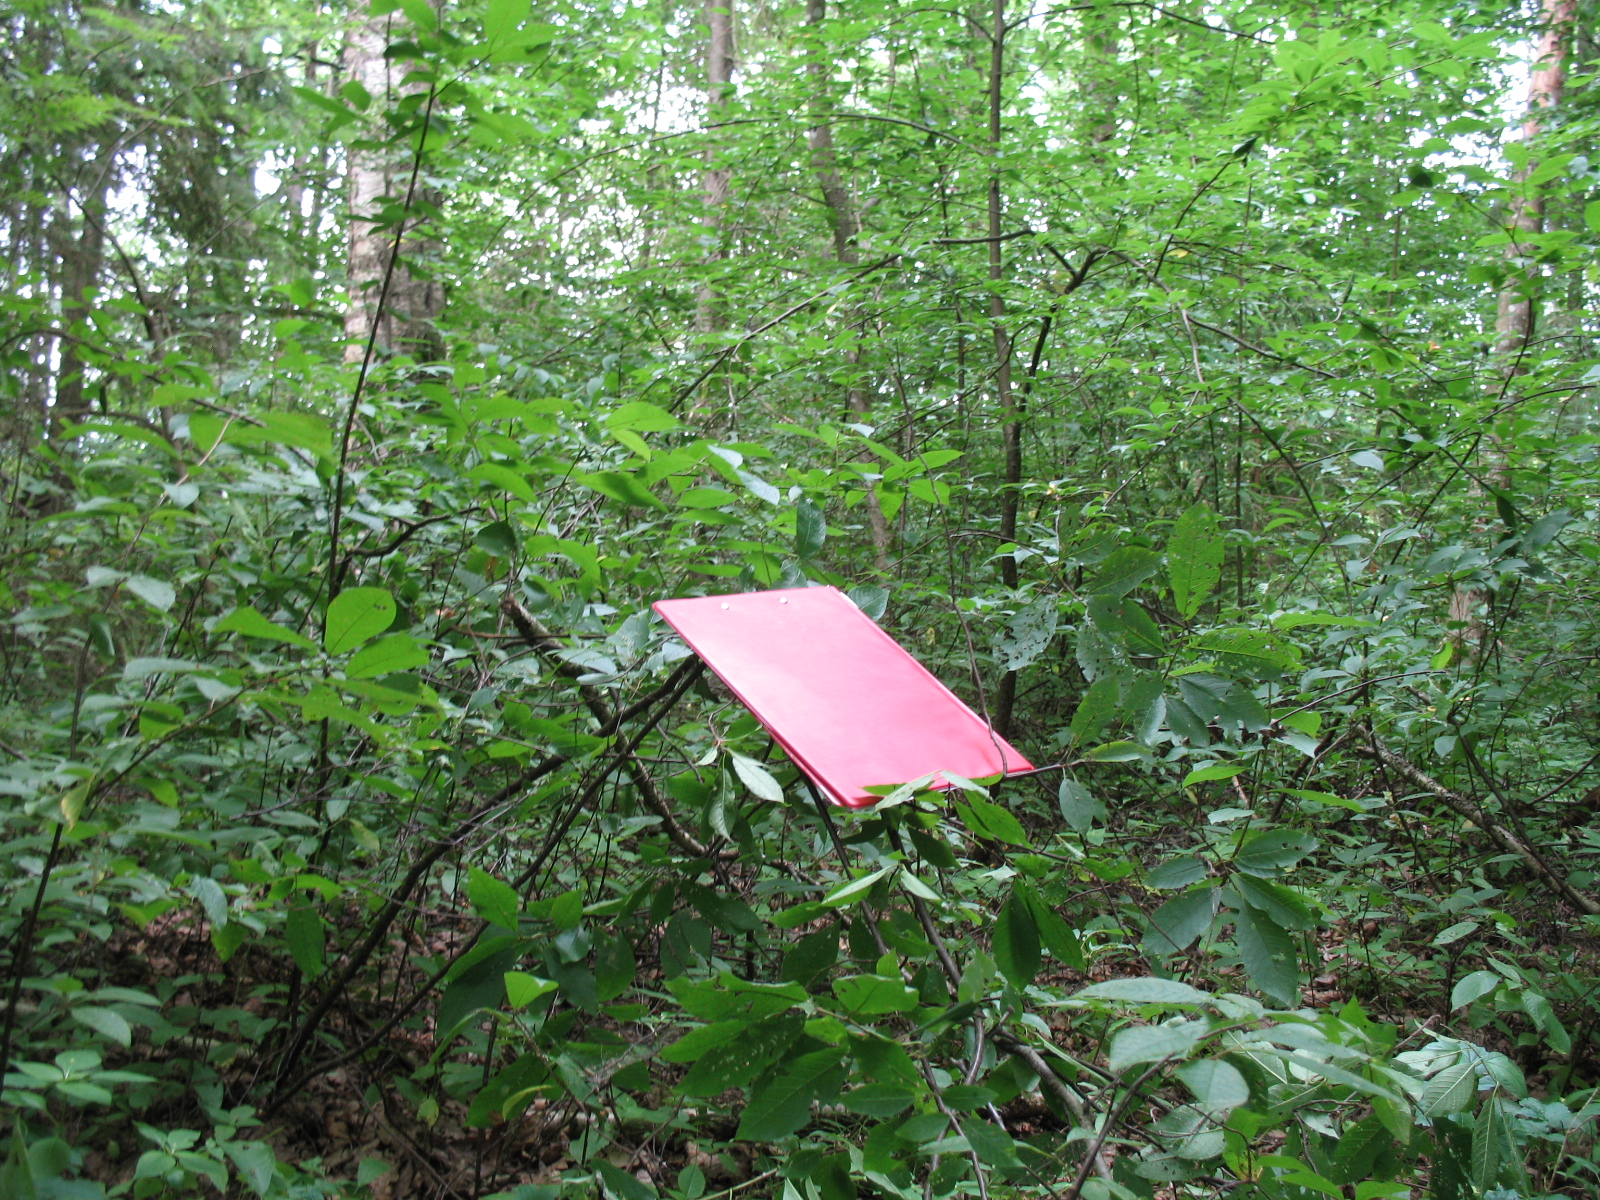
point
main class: Woodland
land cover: Broadleaved woodland
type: non-riverine alder, birch or aspen forest
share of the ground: > 75 %
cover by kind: broadleaved forest trees 80 %, coniferous forest trees 10 %, herbaceous plants 10 %
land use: Forestry
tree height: > 5 m
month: June
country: LV
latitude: 56.7002
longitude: 23.7819
